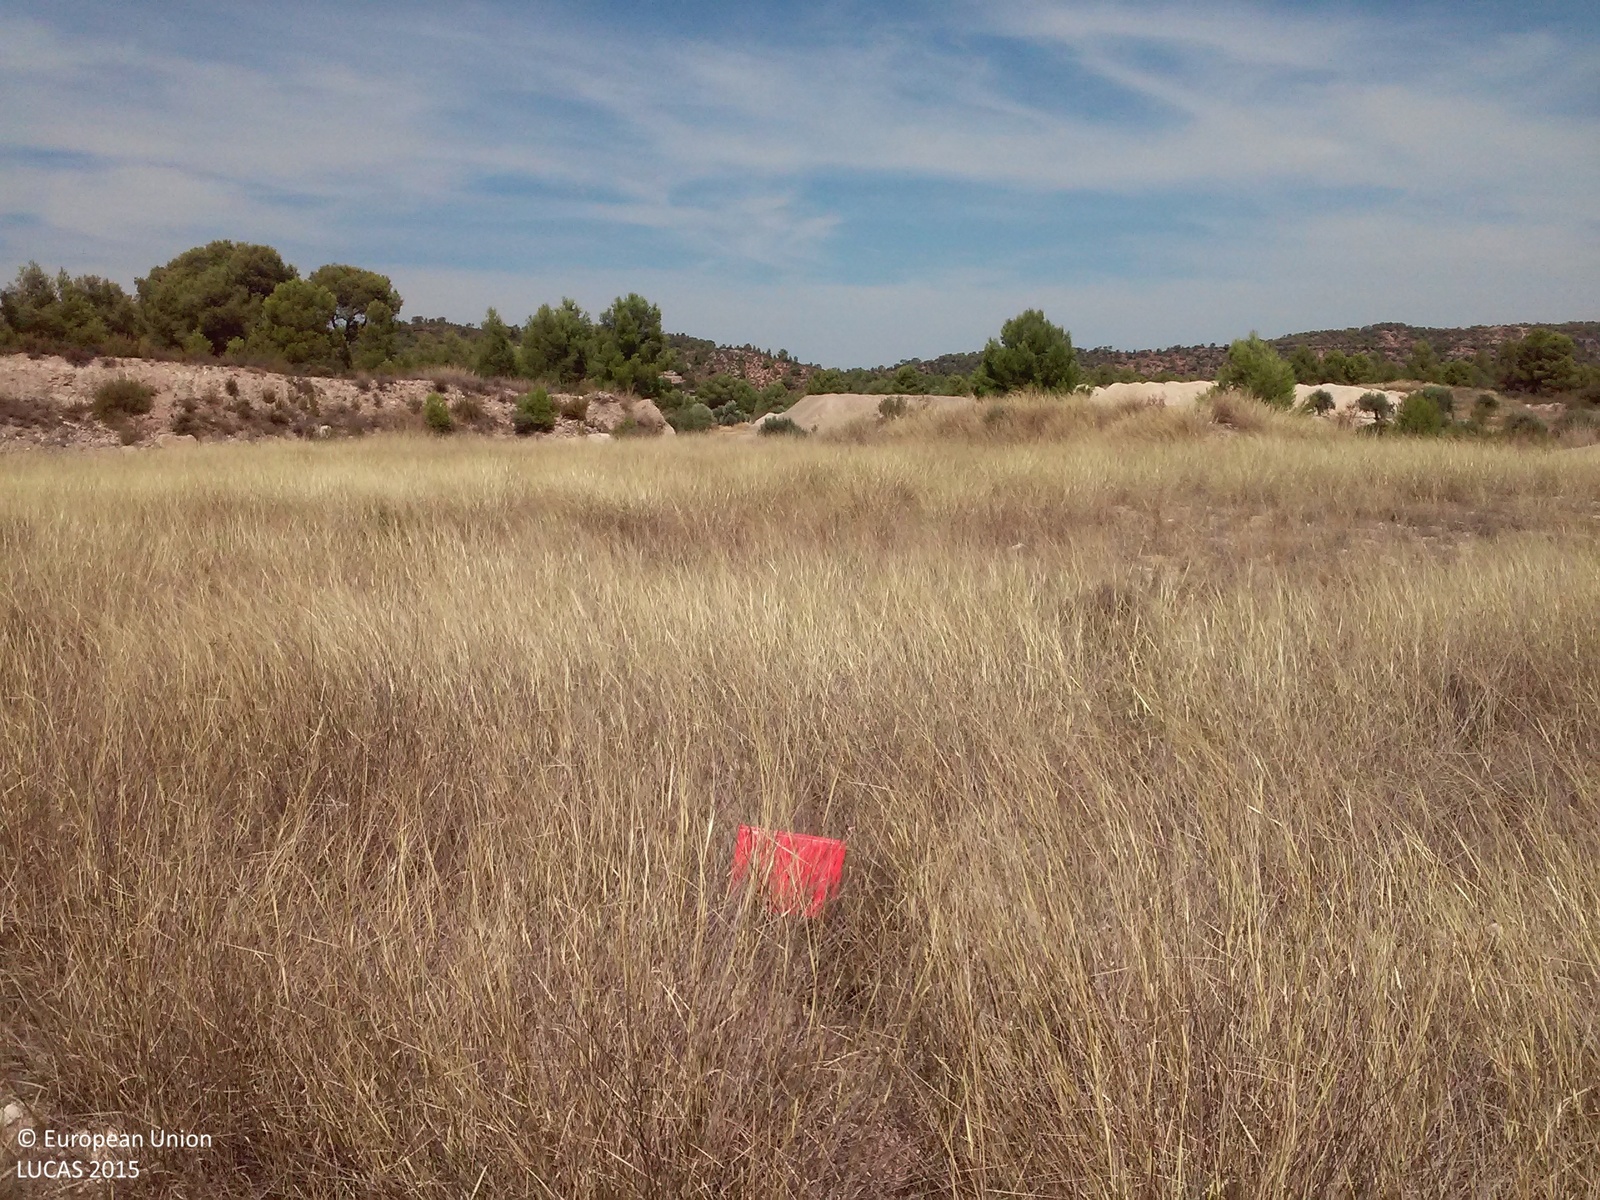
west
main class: Grassland
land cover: Grassland without tree/shrub cover
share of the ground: > 75 %
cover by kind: herbaceous plants 95 %, shrubs 5 %
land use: Abandoned areas
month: August
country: ES
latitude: 41.2479
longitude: 0.5511
